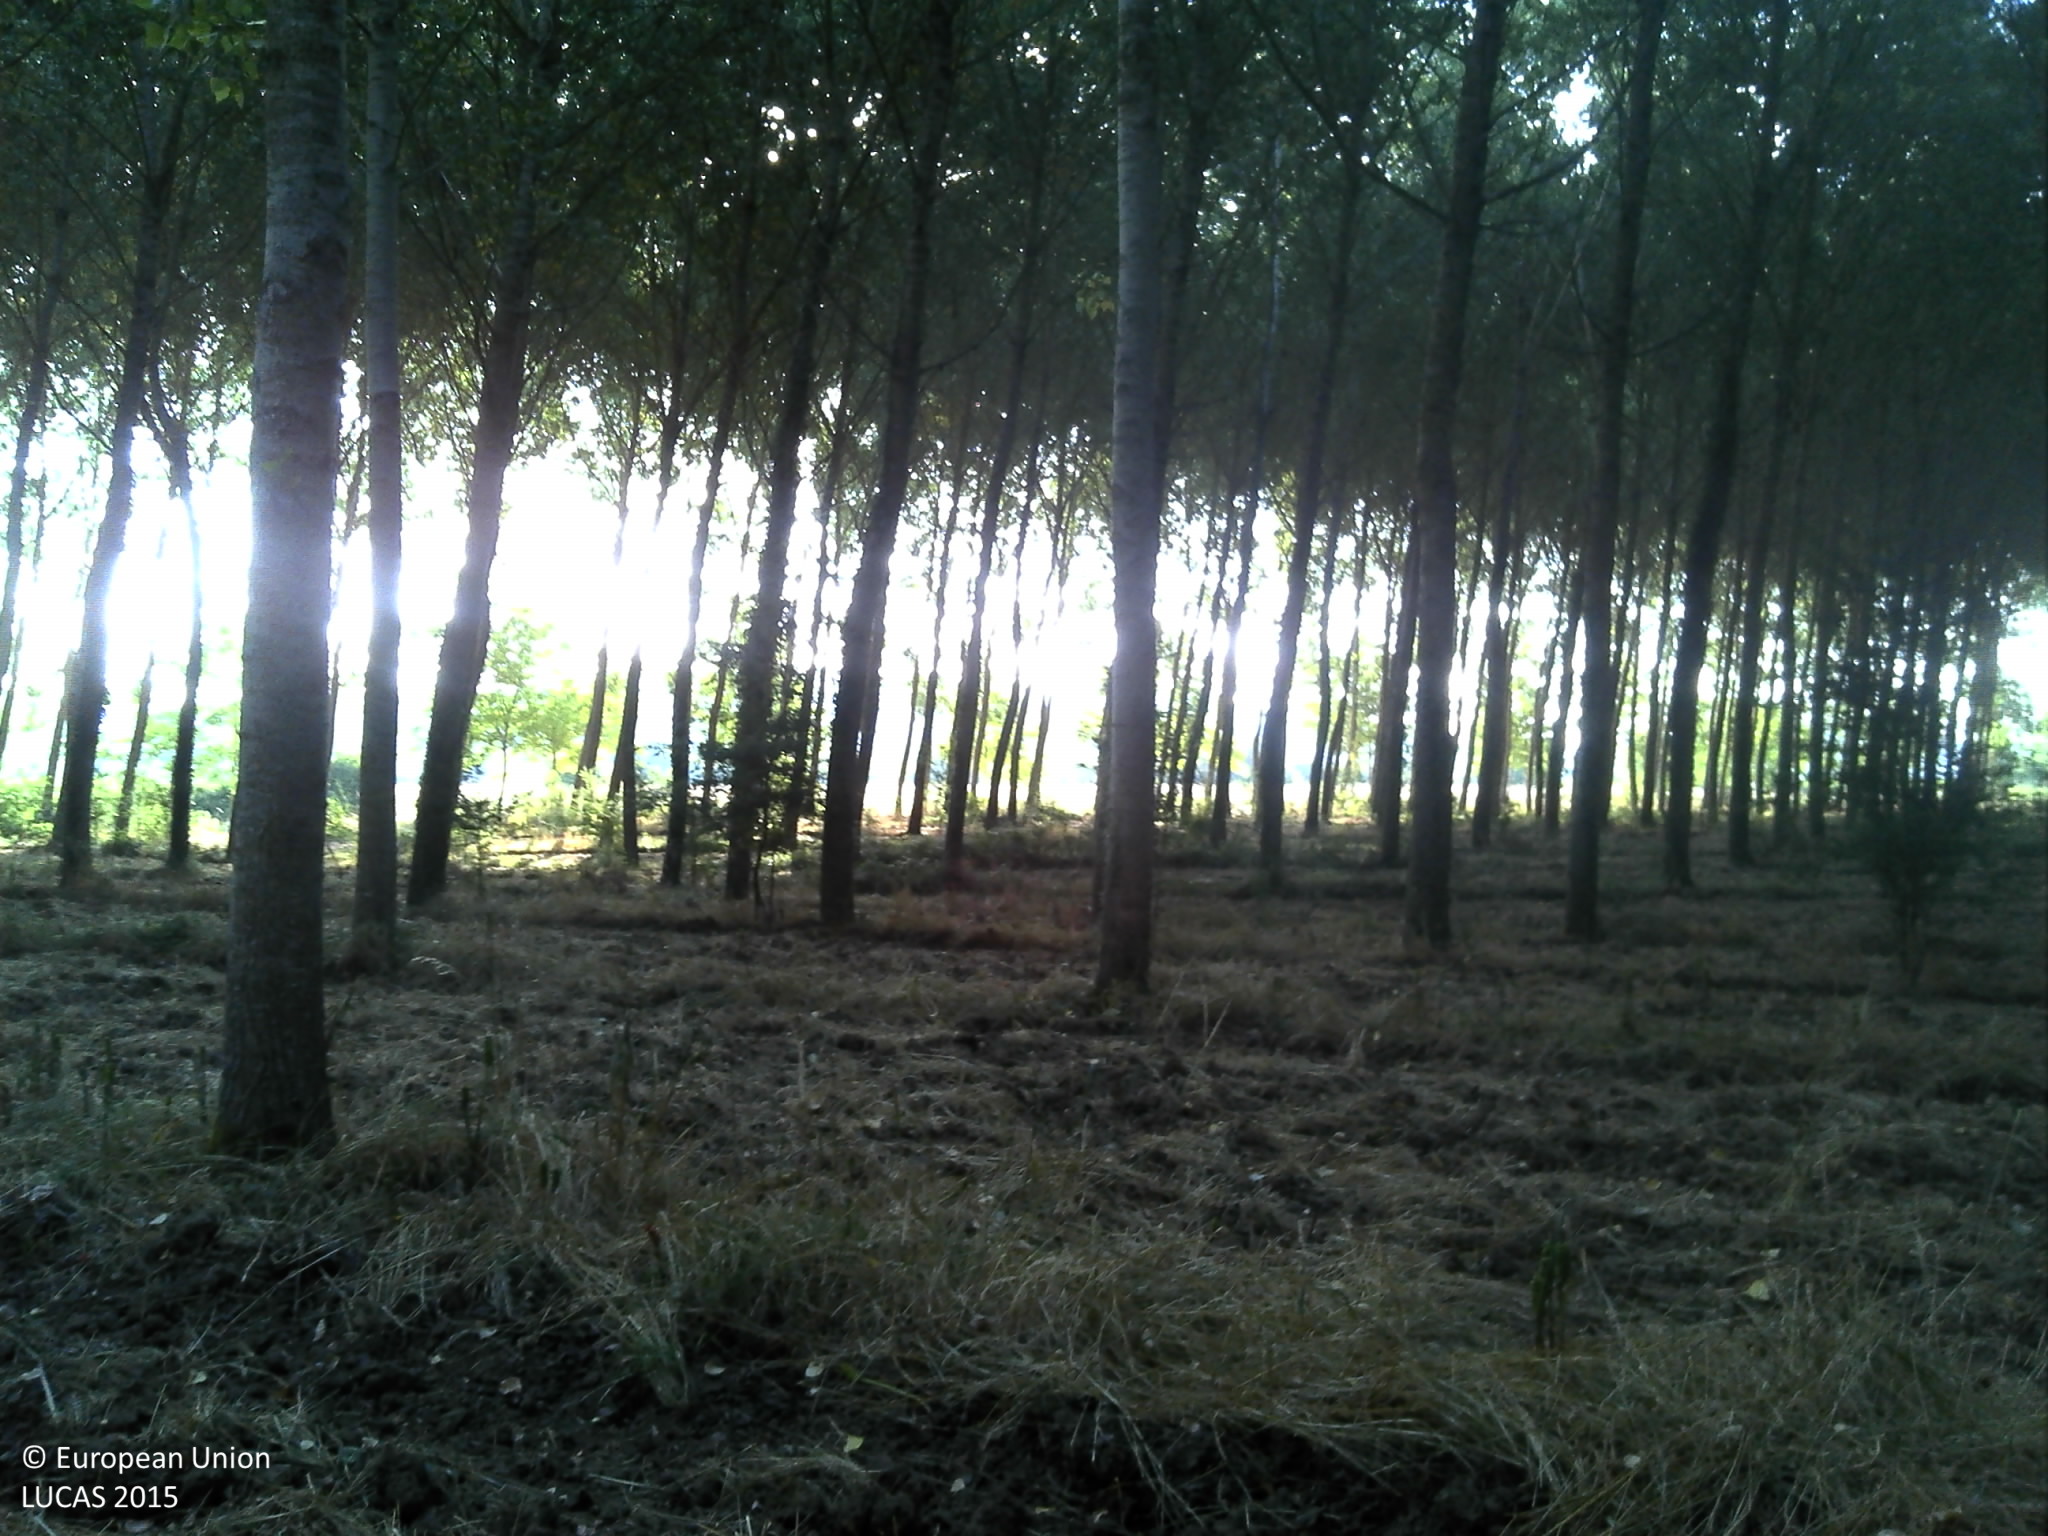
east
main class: Woodland
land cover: Broadleaved woodland
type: exotic forest
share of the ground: > 75 %
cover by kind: broadleaved forest trees 80 %, herbaceous plants 10 %, shrubs 5 %, lichens and mosses 5 %
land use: Forestry
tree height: > 5 m
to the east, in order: Broadleaved woodland; Spontaneously vegetated surfaces; Rivers and streams; Spontaneously vegetated surfaces; Broadleaved woodland
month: July
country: FR
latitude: 44.7139
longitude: -0.4306
